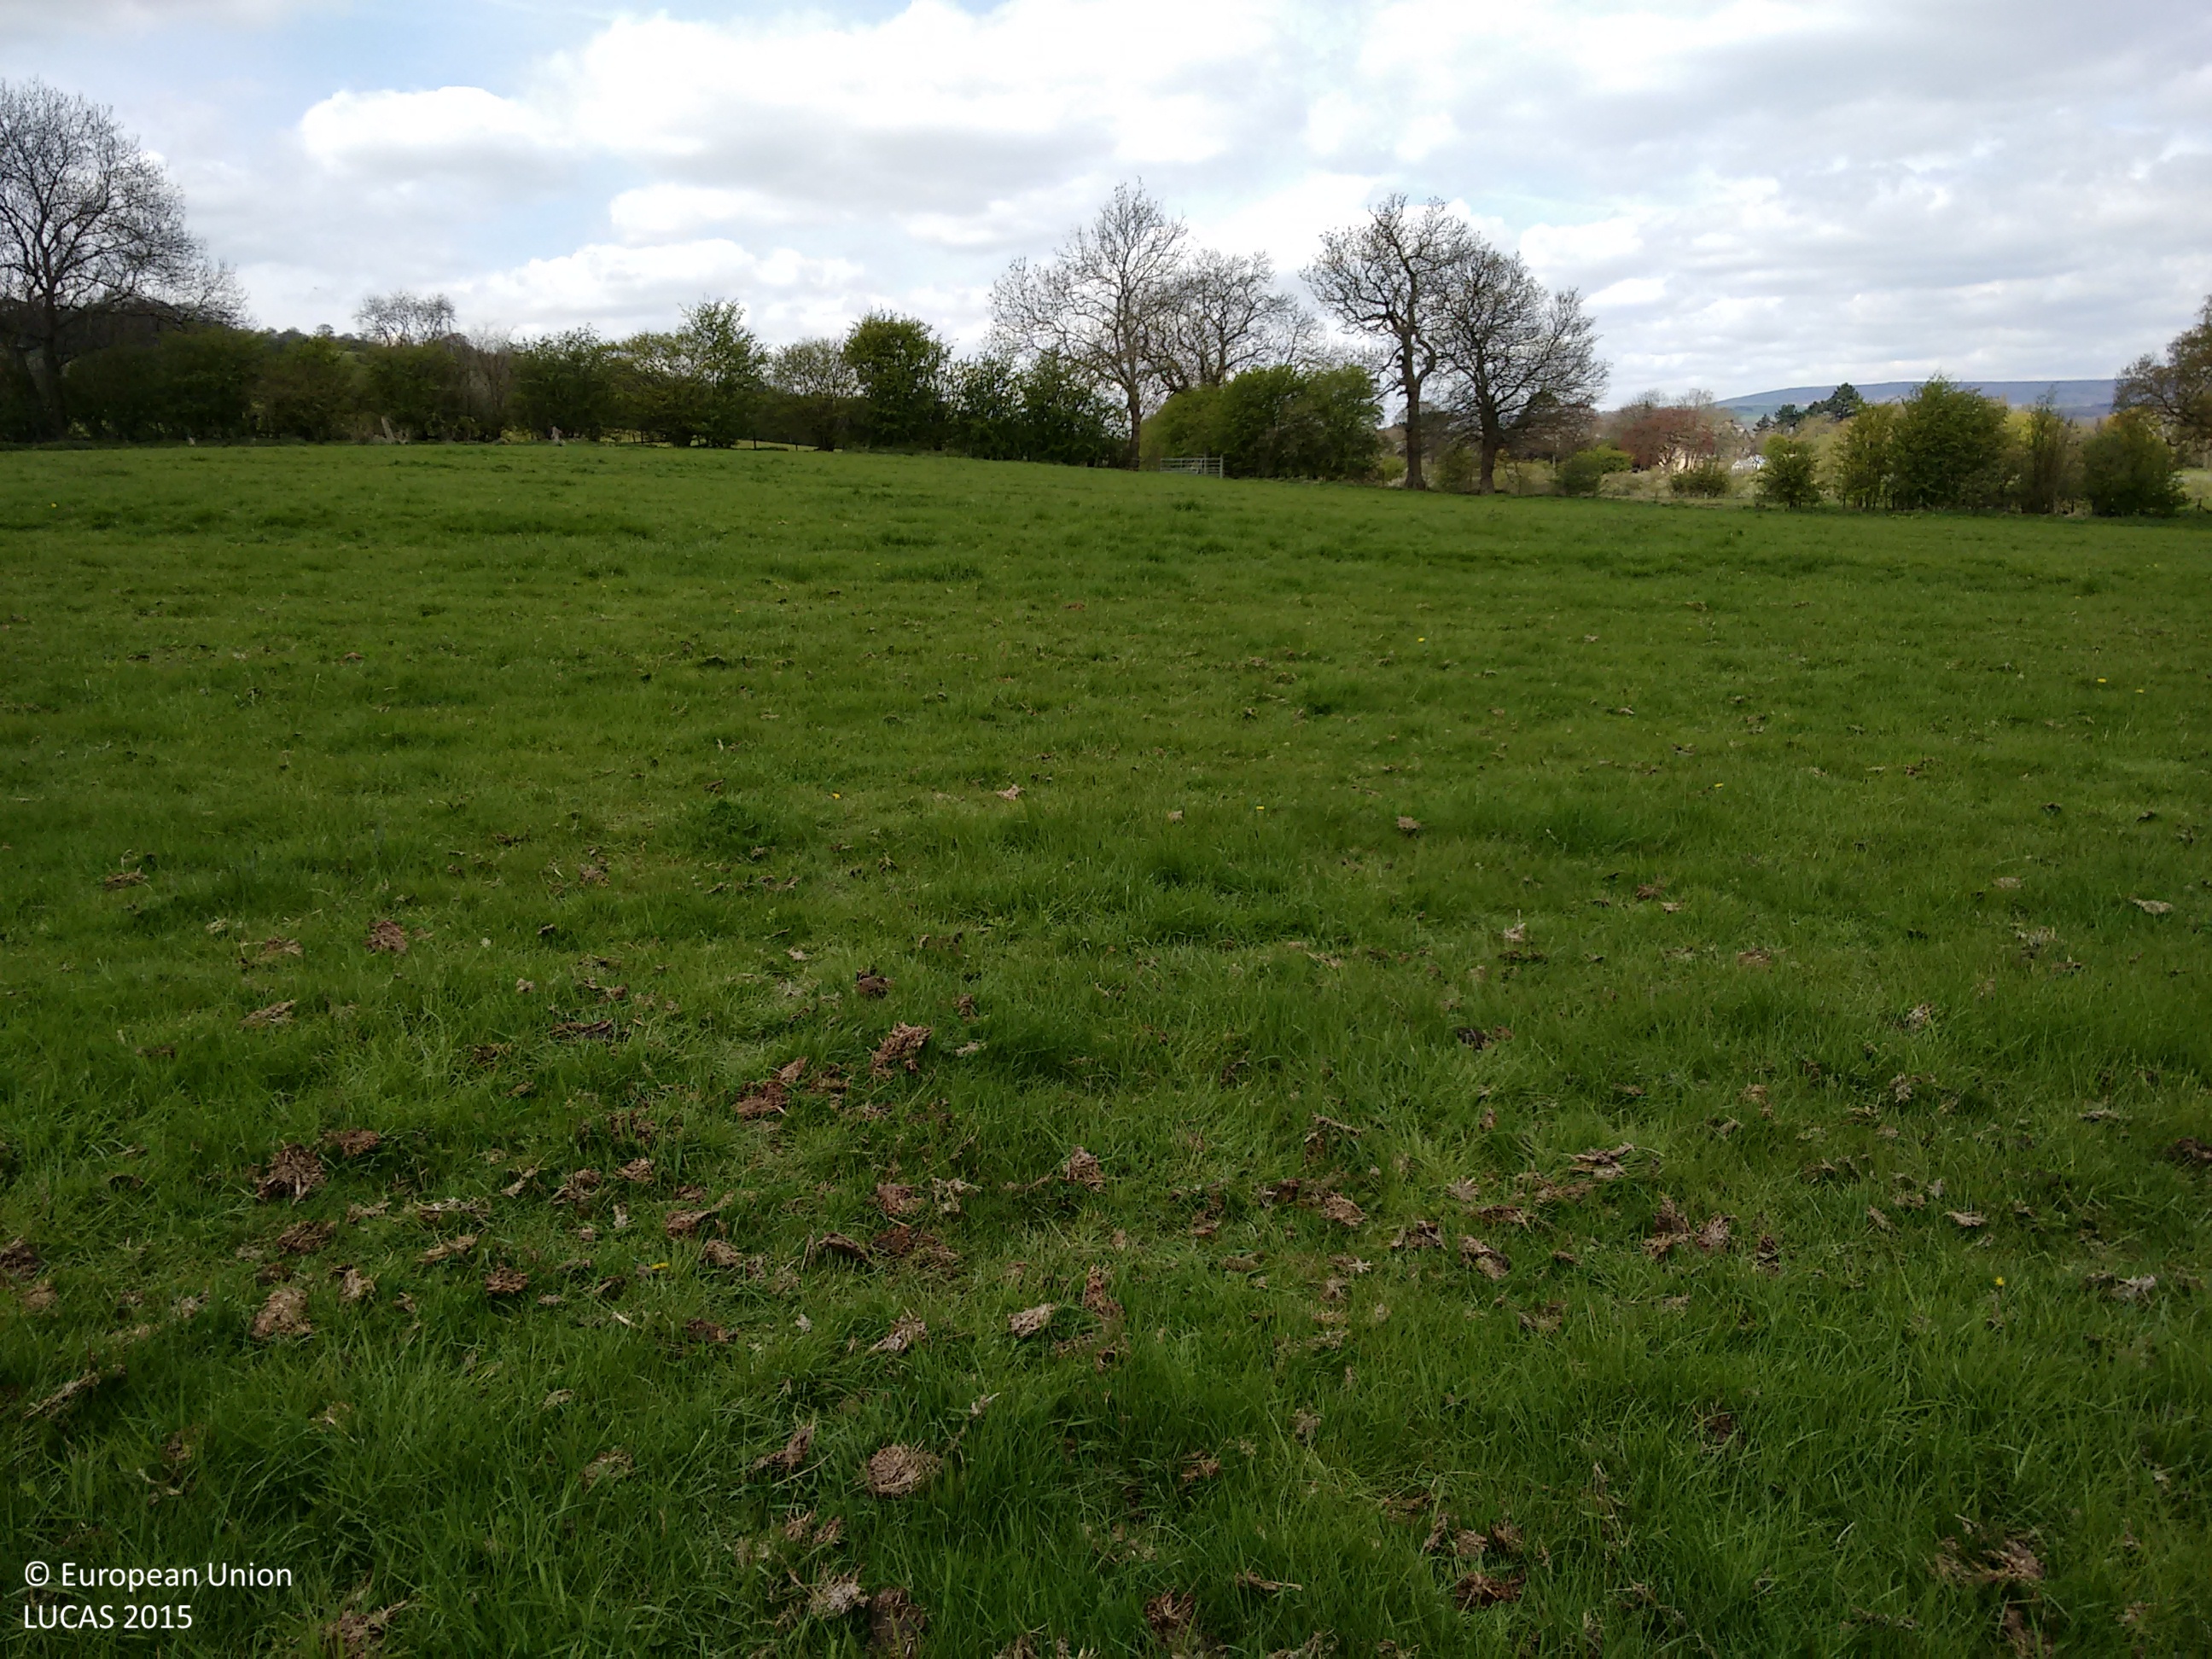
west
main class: Grassland
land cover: Grassland without tree/shrub cover
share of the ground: > 75 %
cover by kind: herbaceous plants 100 %
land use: Agriculture (excluding fallow land and kitchen gardens)
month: May
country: GB
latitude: 53.9171
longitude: -1.7616
